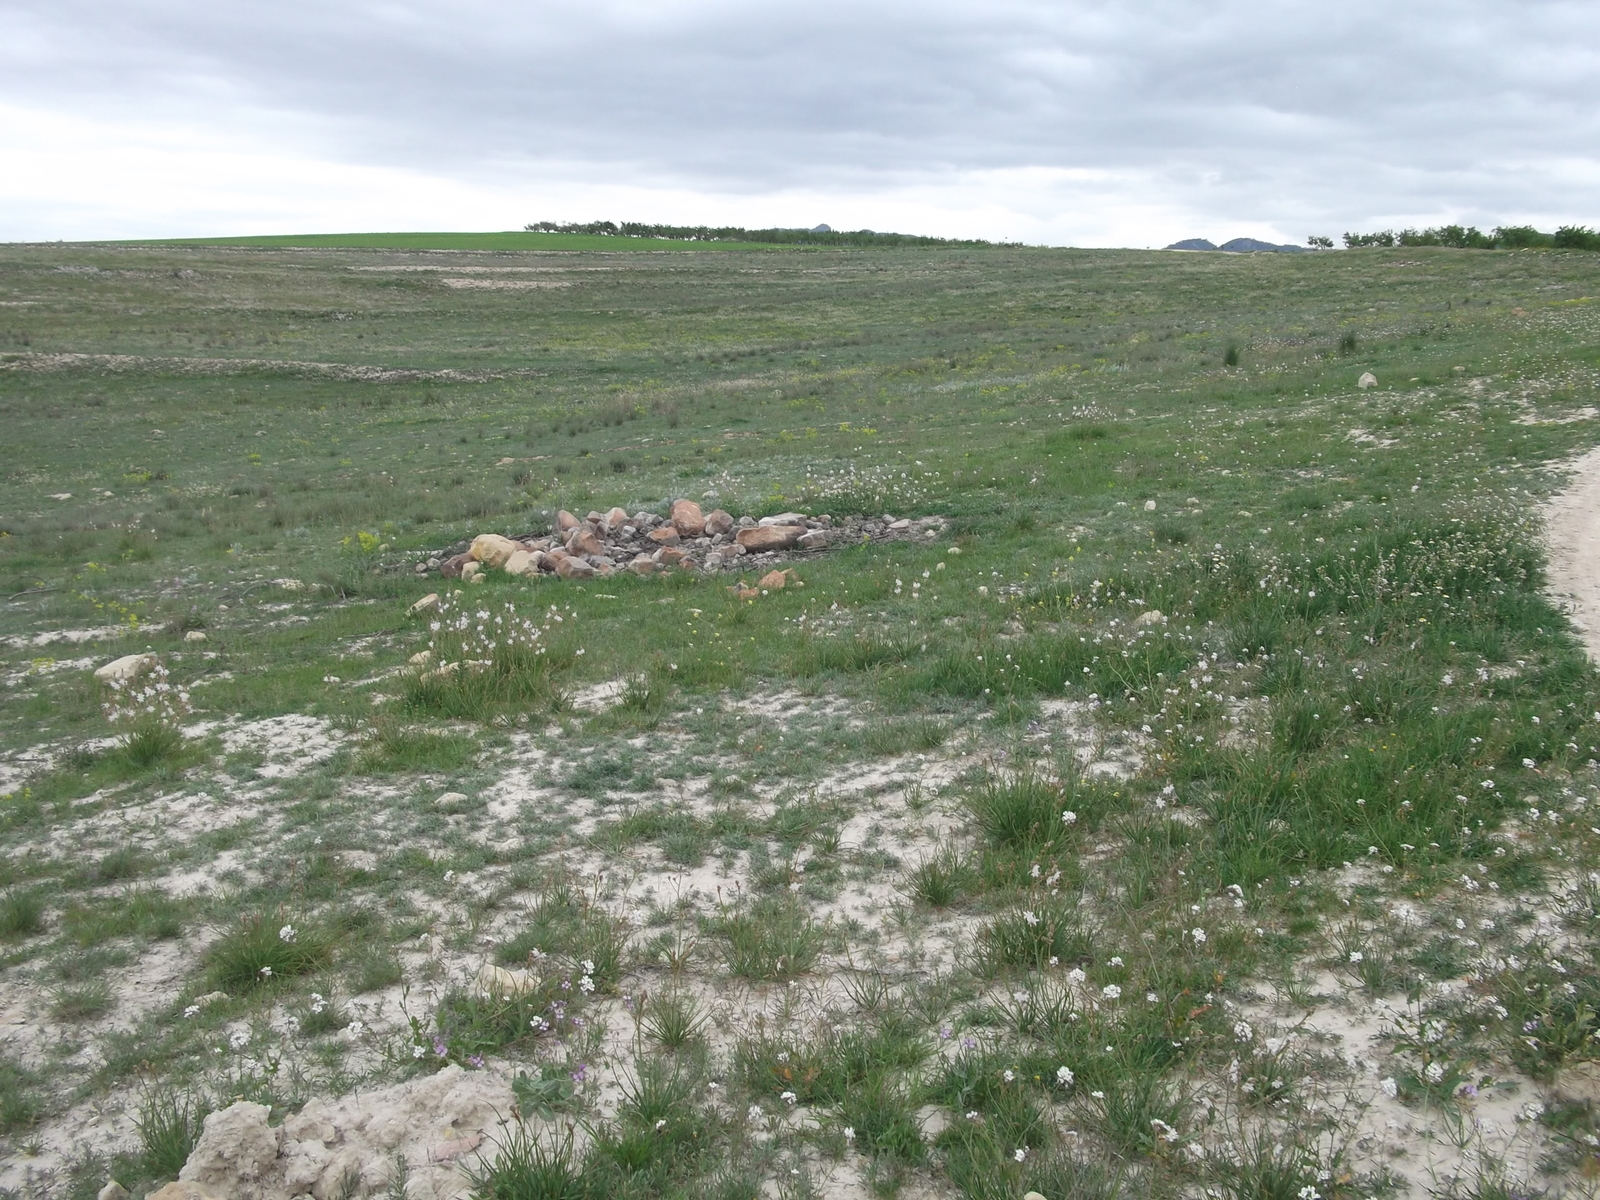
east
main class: Grassland
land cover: Grassland without tree/shrub cover
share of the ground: 50 - 75 %
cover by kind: herbaceous plants 50 %, consolidated bare surface 50 %
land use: Abandoned areas
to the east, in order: Grassland without tree/shrub cover; Grass margins; Barley
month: April
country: ES
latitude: 38.1396
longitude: -1.5458
